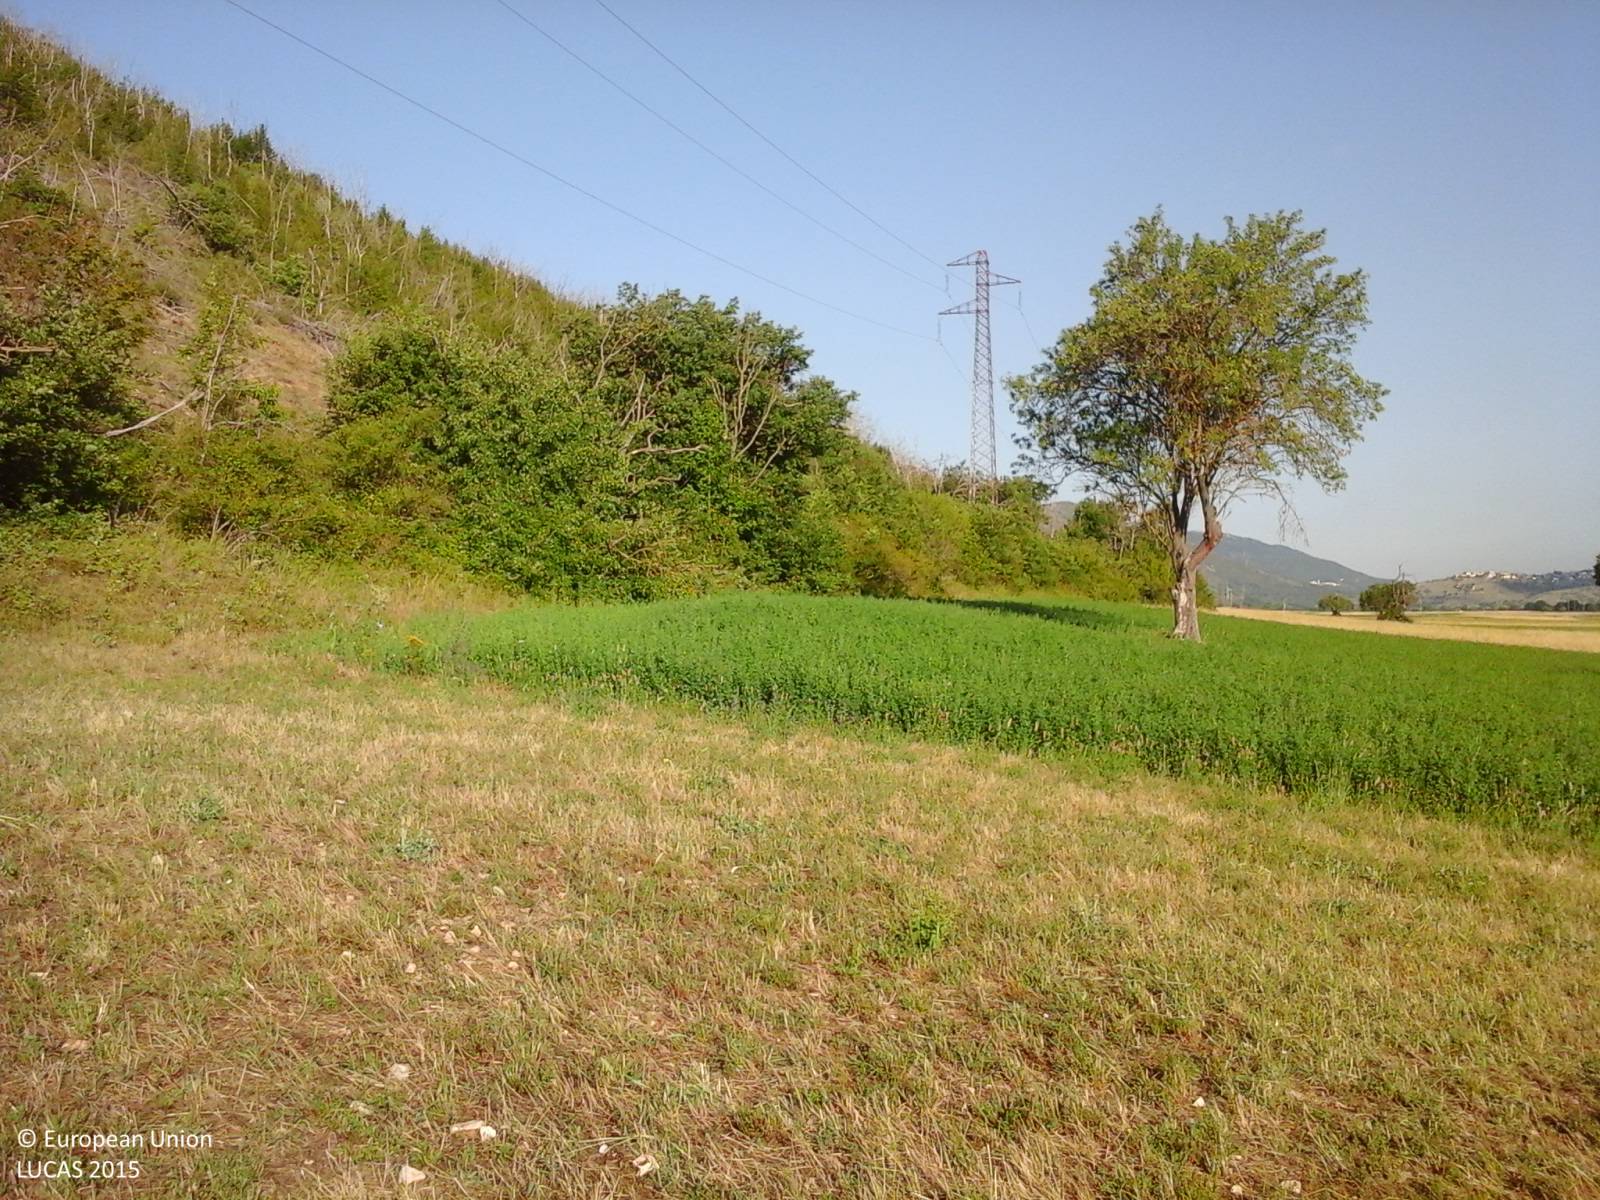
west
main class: Cropland
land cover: Rye
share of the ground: > 75 %
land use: Agriculture (excluding fallow land and kitchen gardens)
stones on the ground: 25 - 50 %
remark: Harvested field
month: June
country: IT
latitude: 42.2228
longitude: 13.7557
